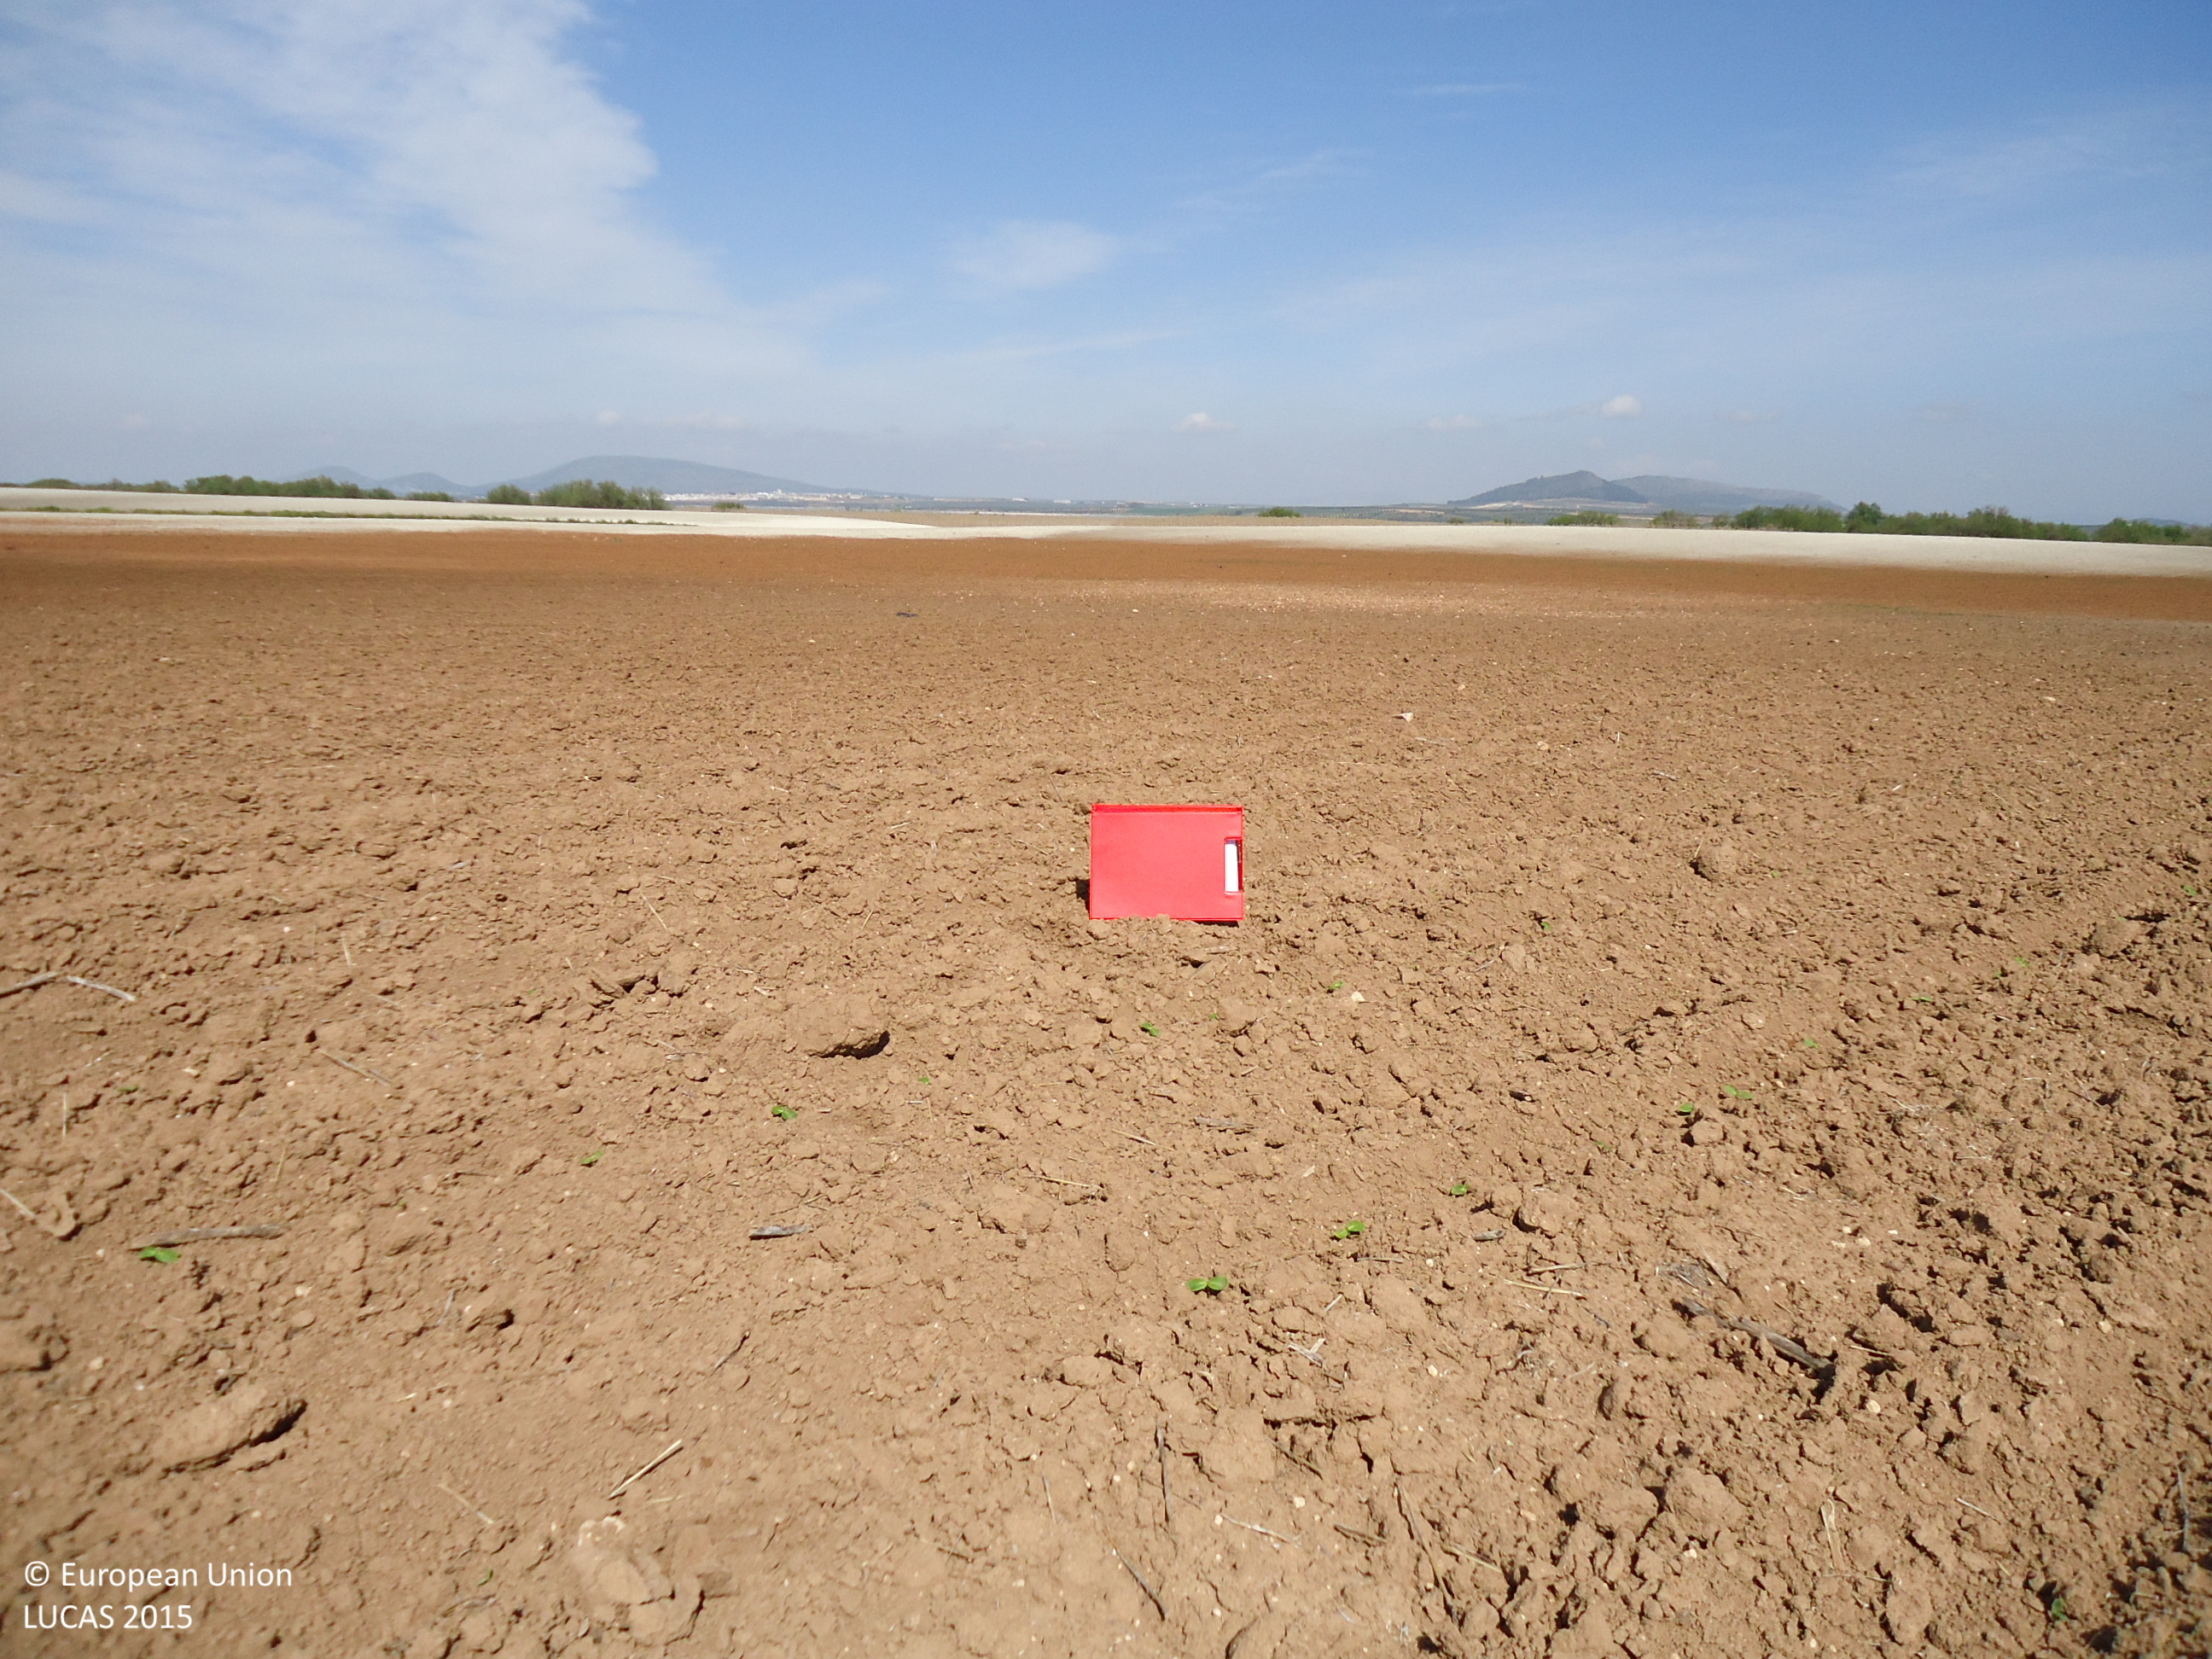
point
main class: Cropland
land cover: Sunflower
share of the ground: < 10 %
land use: Agriculture (excluding fallow land and kitchen gardens)
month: April
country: ES
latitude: 37.0983
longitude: -4.7967
